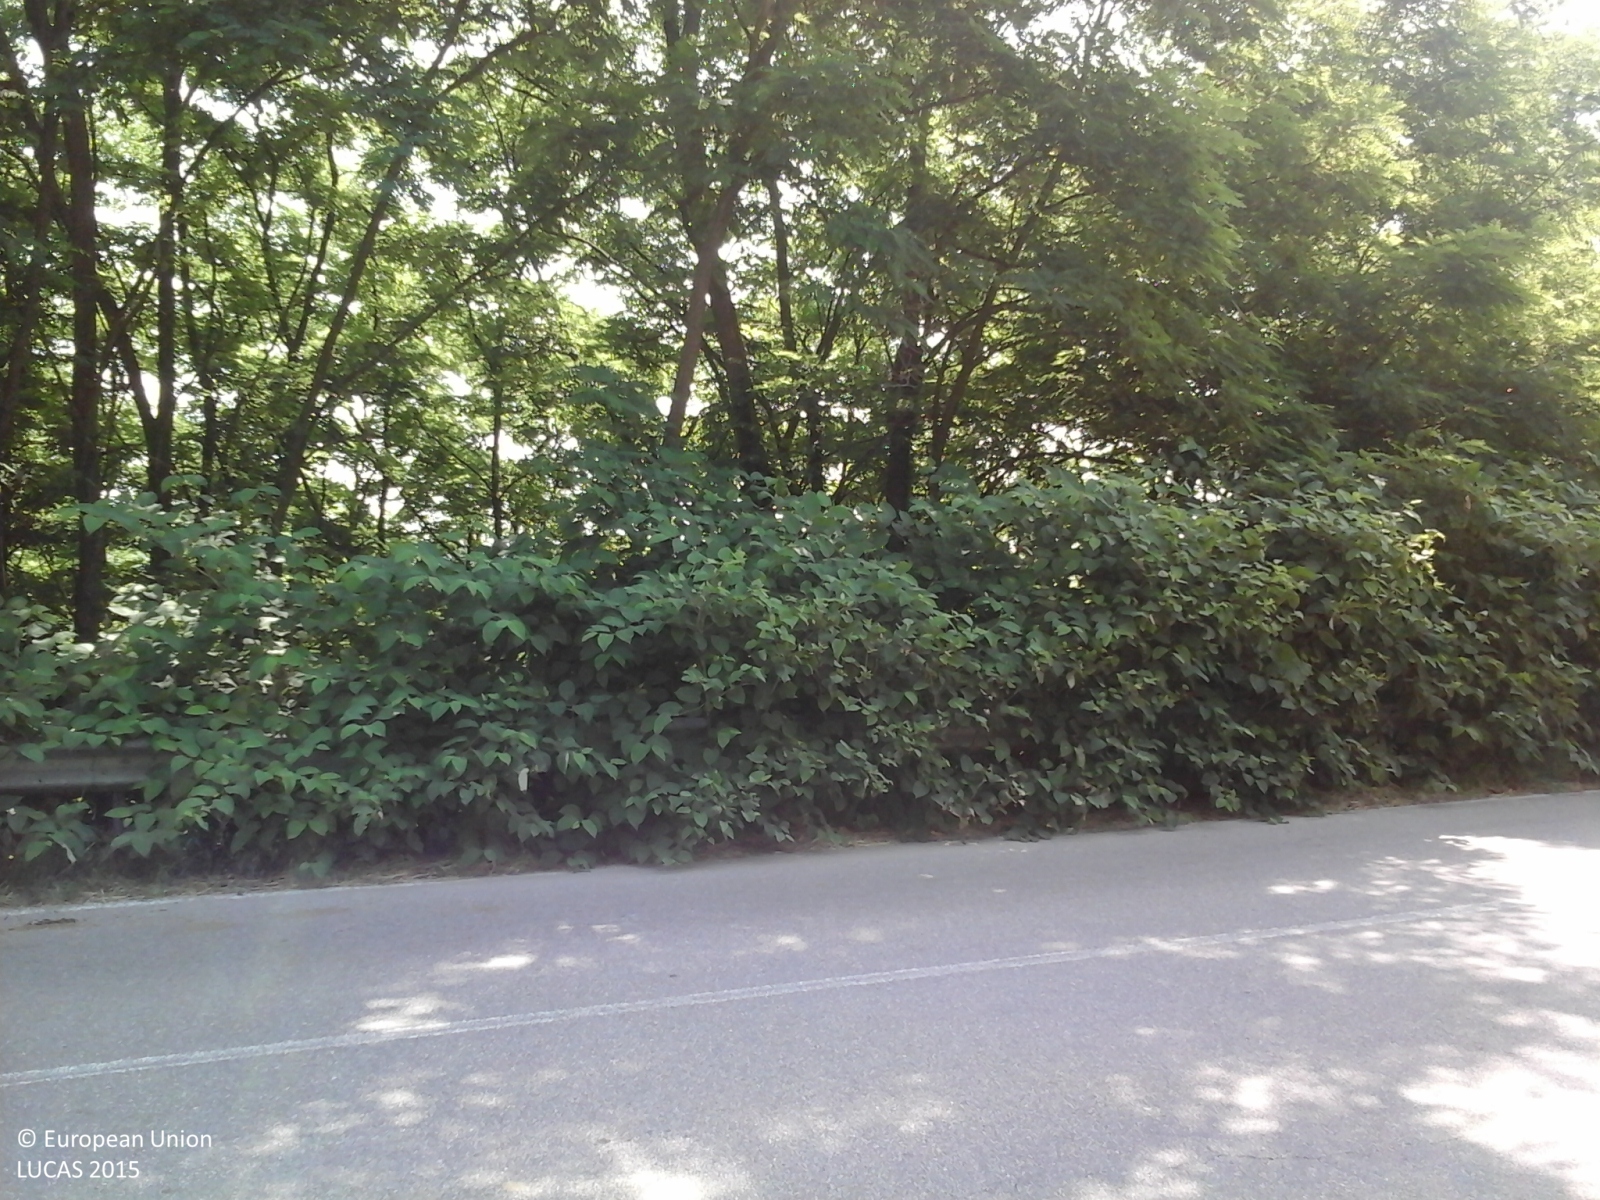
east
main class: Woodland
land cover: Broadleaved woodland
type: thermophilous deciduous forest
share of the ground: > 75 %
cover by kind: broadleaved forest trees 100 %
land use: Forestry
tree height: > 5 m
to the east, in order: Broadleaved woodland; Fences; Paved roads, cycling and walking lanes; Broadleaved woodland; Grassland without tree/shrub cover; Electric lines; Grassland without tree/shrub cover
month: June
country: IT
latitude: 45.5255
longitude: 8.2232
